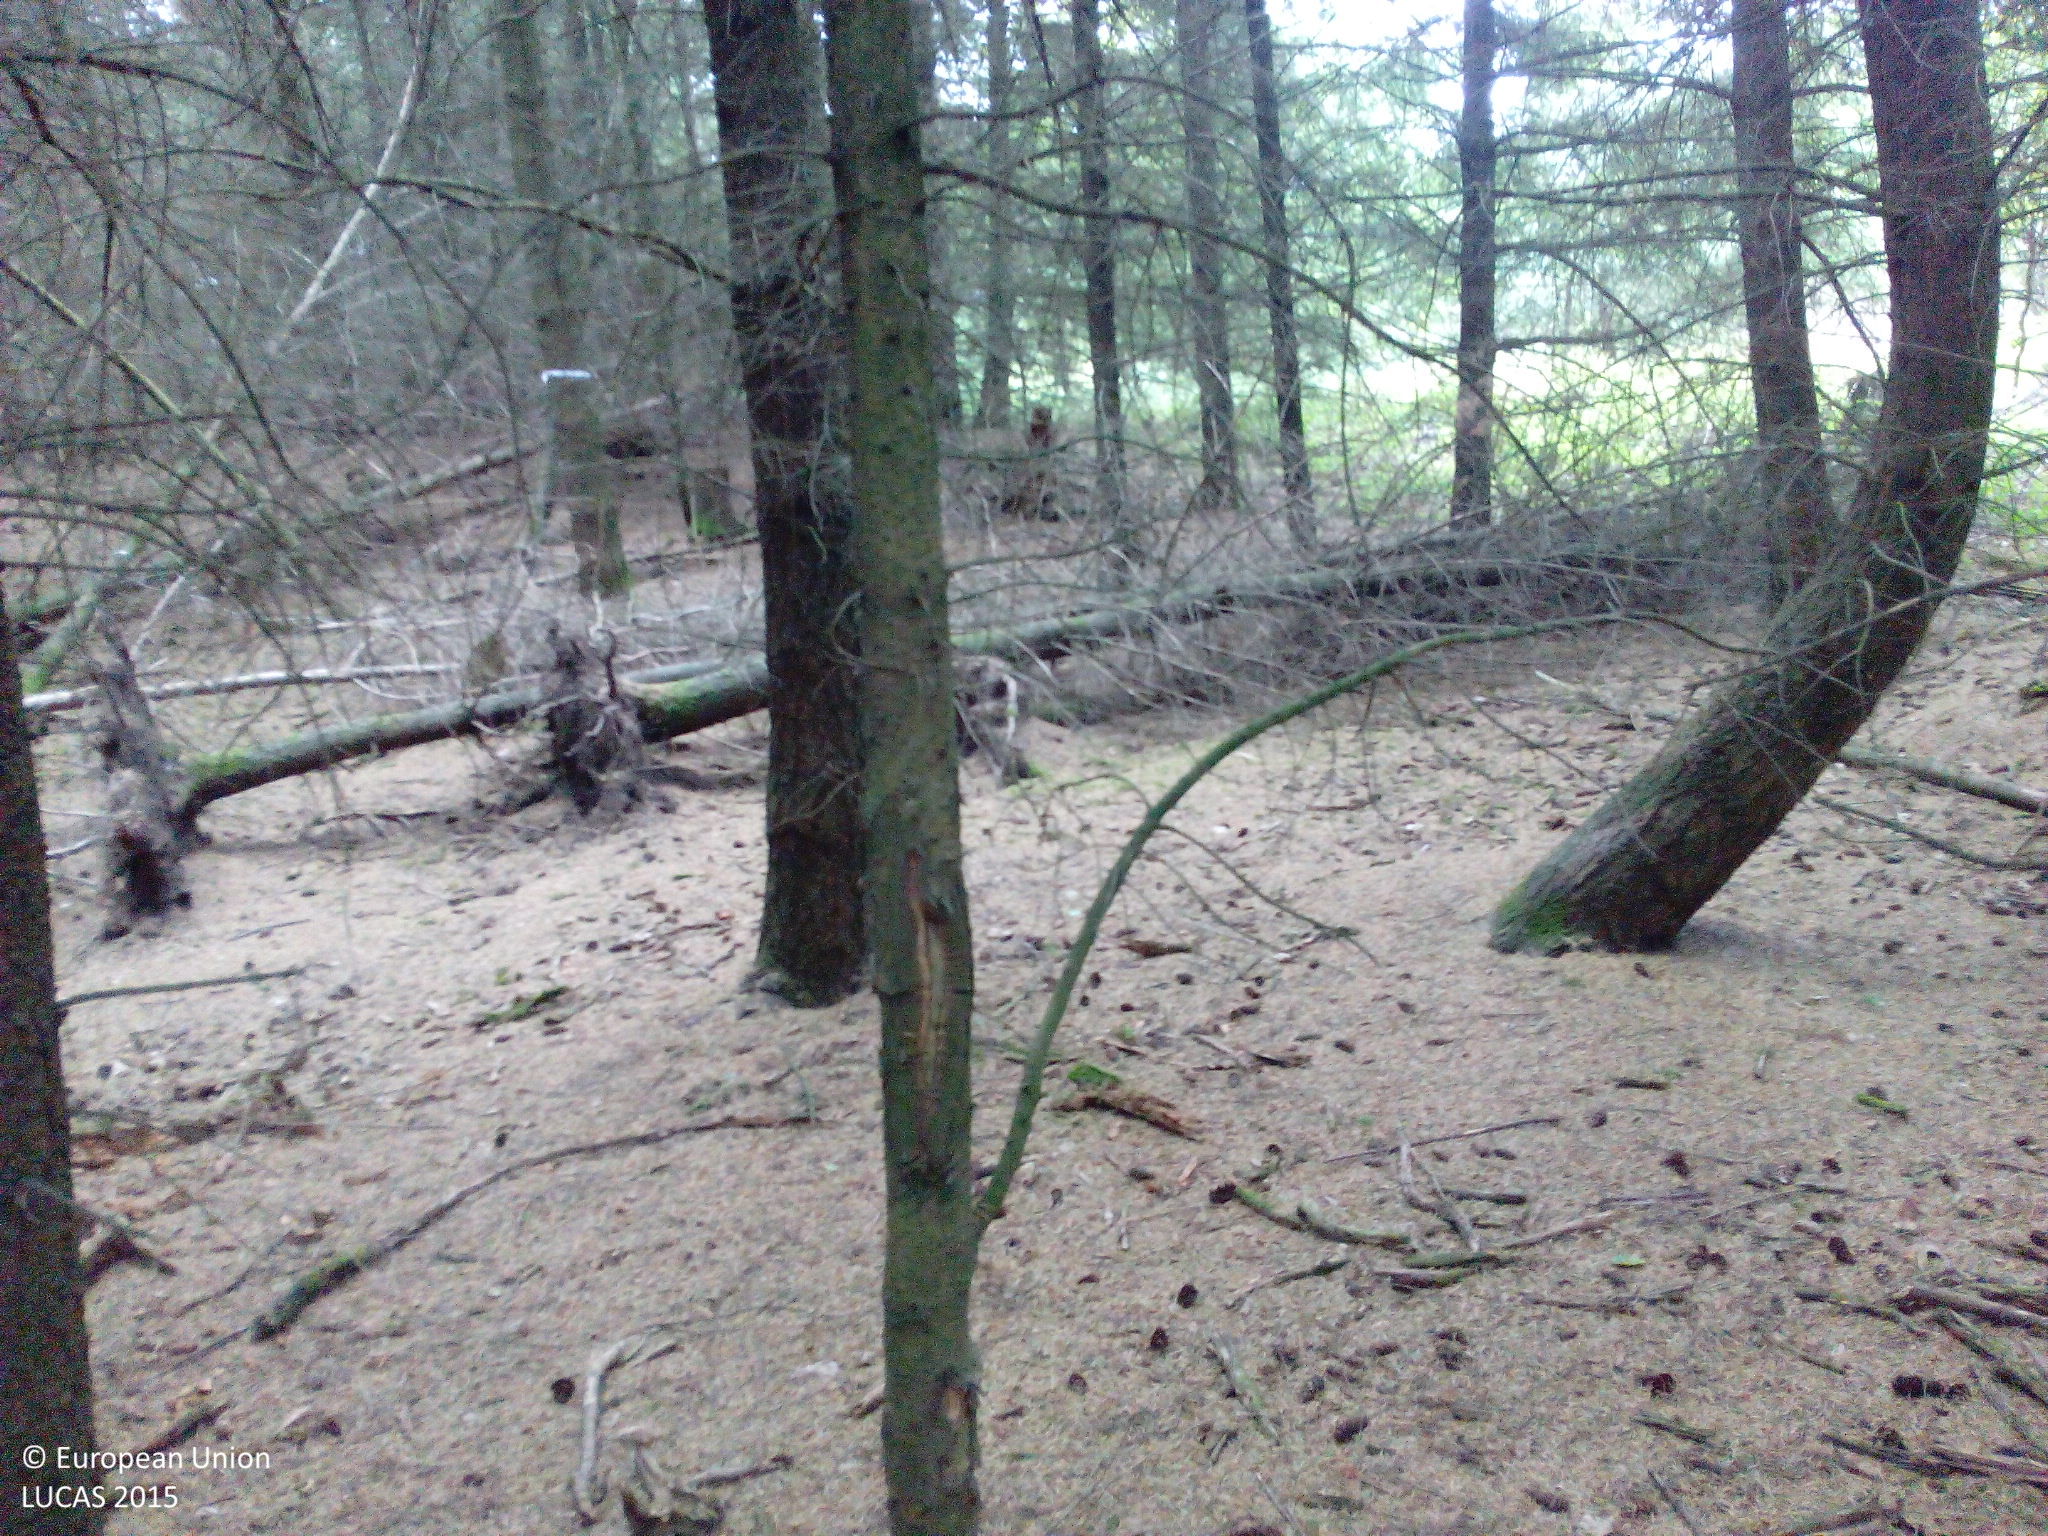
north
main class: Woodland
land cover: Other coniferous woodland
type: exotic forest
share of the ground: > 75 %
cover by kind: coniferous forest trees 100 %
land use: Forestry
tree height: > 5 m
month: July
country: DE
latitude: 50.0382
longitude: 7.0541
